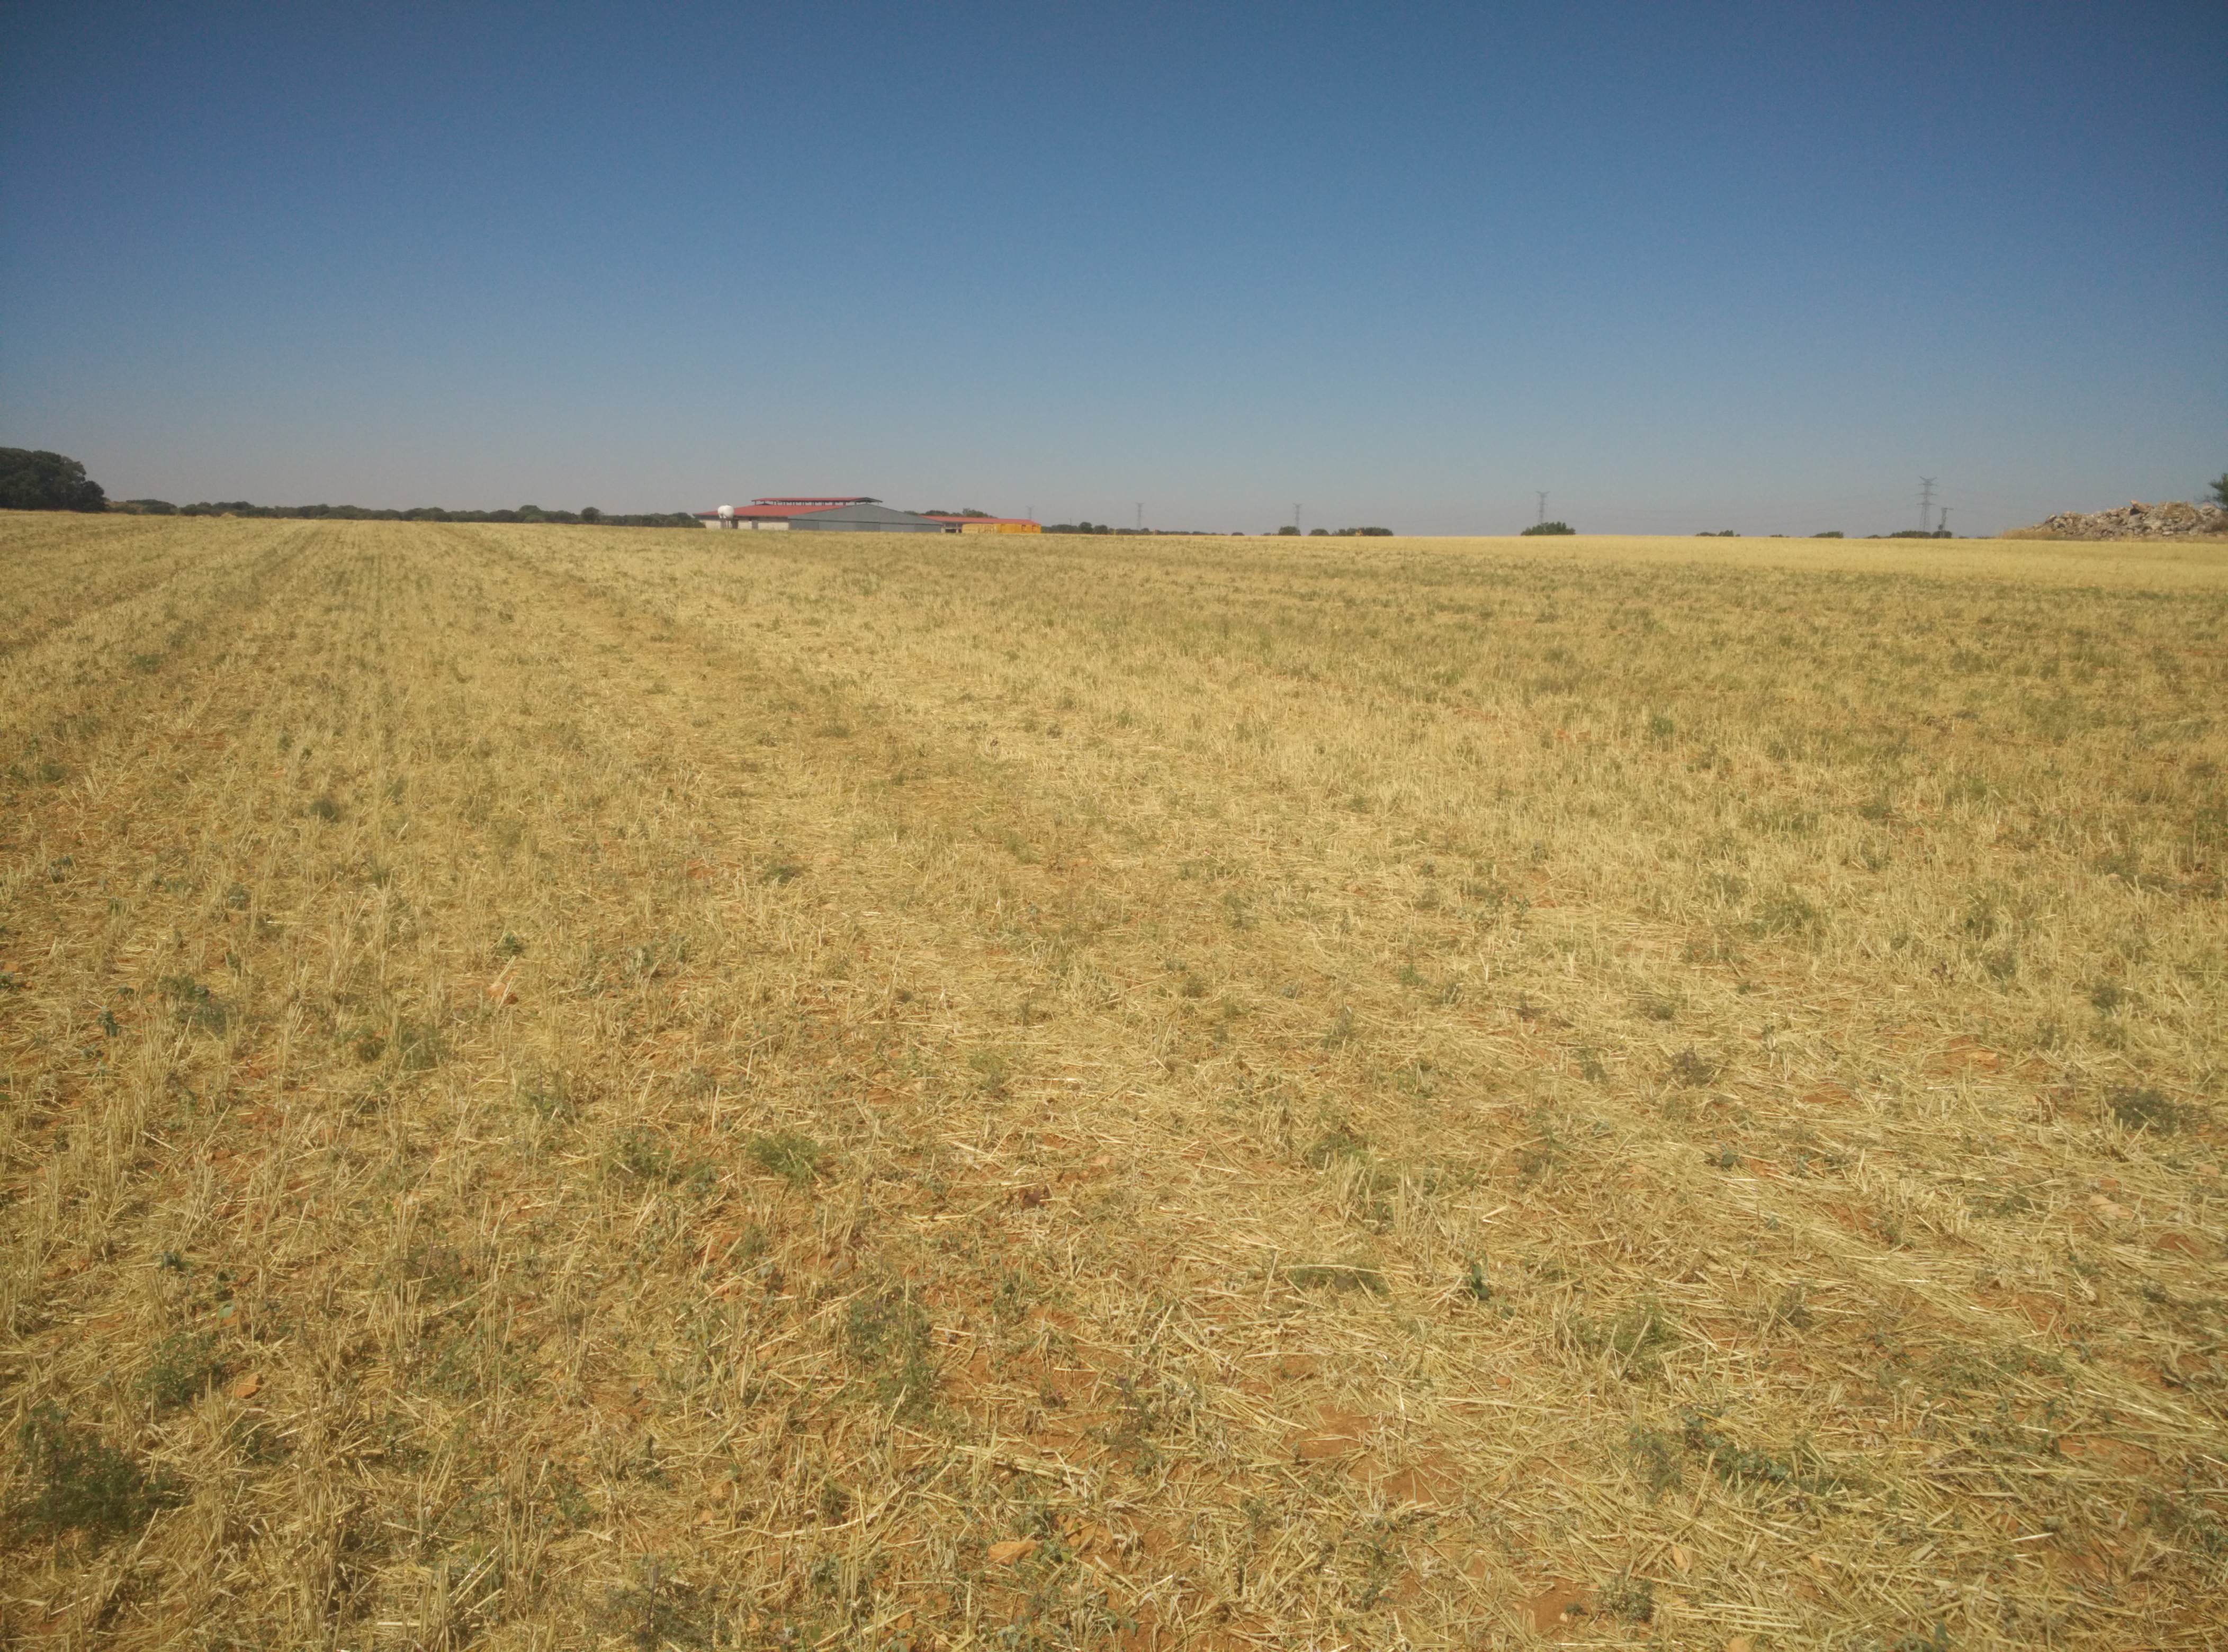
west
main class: Cropland
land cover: Barley
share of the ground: < 10 %
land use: Agriculture (excluding fallow land and kitchen gardens)
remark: Harvested field
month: July
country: ES
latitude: 40.8446
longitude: -2.8536
